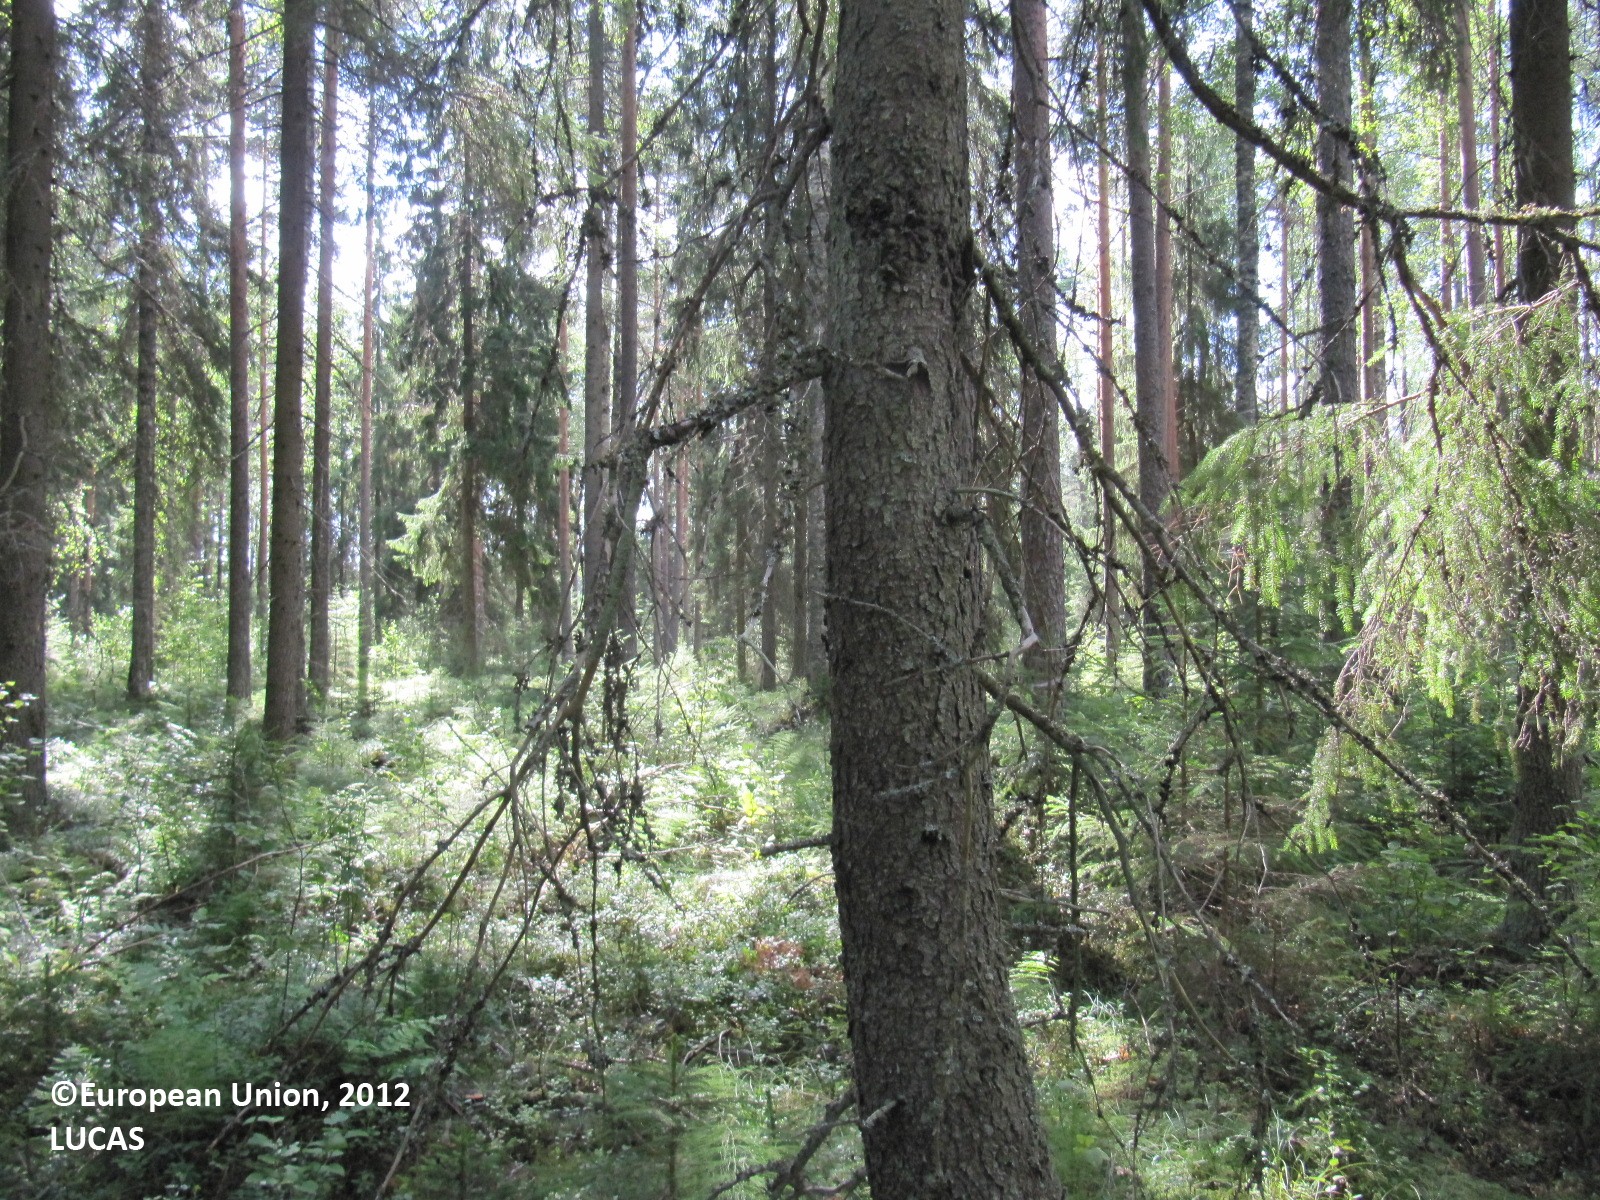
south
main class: Woodland
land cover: Spruce dominated coniferous woodland
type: boreal forest
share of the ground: > 75 %
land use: Forestry
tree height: > 5 m
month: August
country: FI
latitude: 60.7614
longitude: 24.3621
